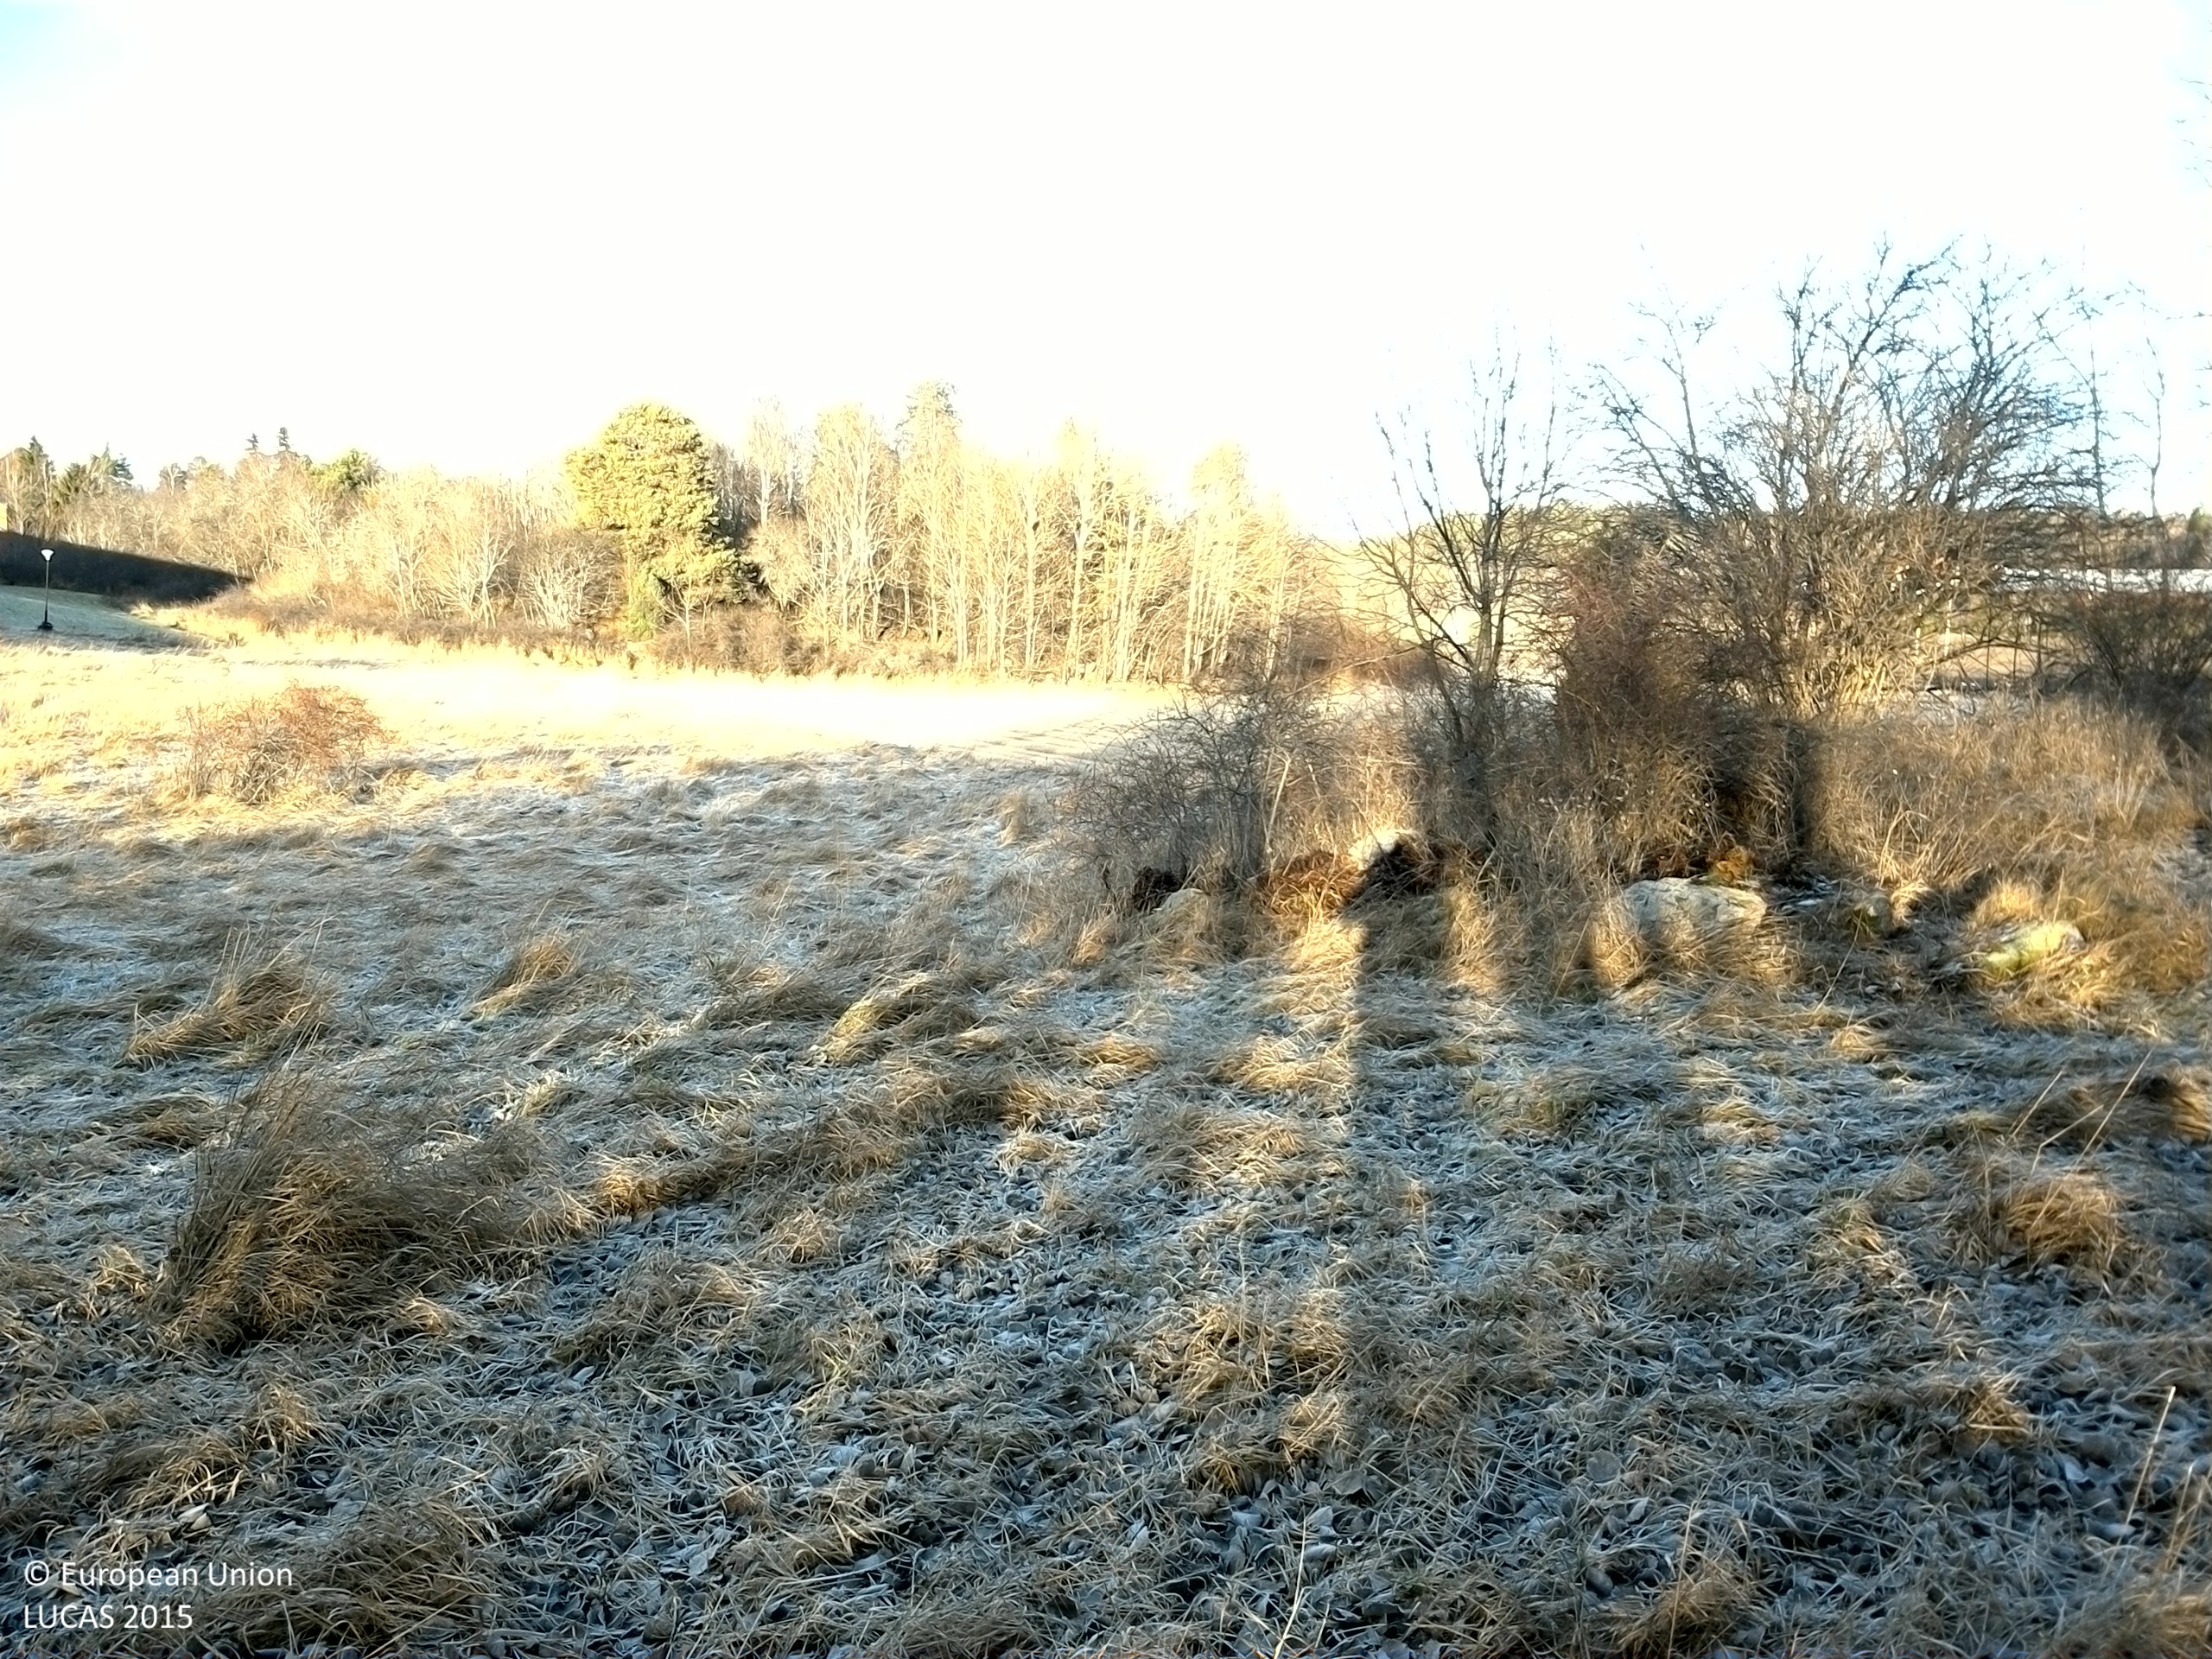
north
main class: Grassland
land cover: Grassland with sparse tree/shrub cover
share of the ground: > 75 %
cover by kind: herbaceous plants 90 %, broadleaved forest trees 5 %, shrubs 5 %
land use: Fallow land
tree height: > 5 m
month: December
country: SE
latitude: 59.4168
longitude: 16.4949
